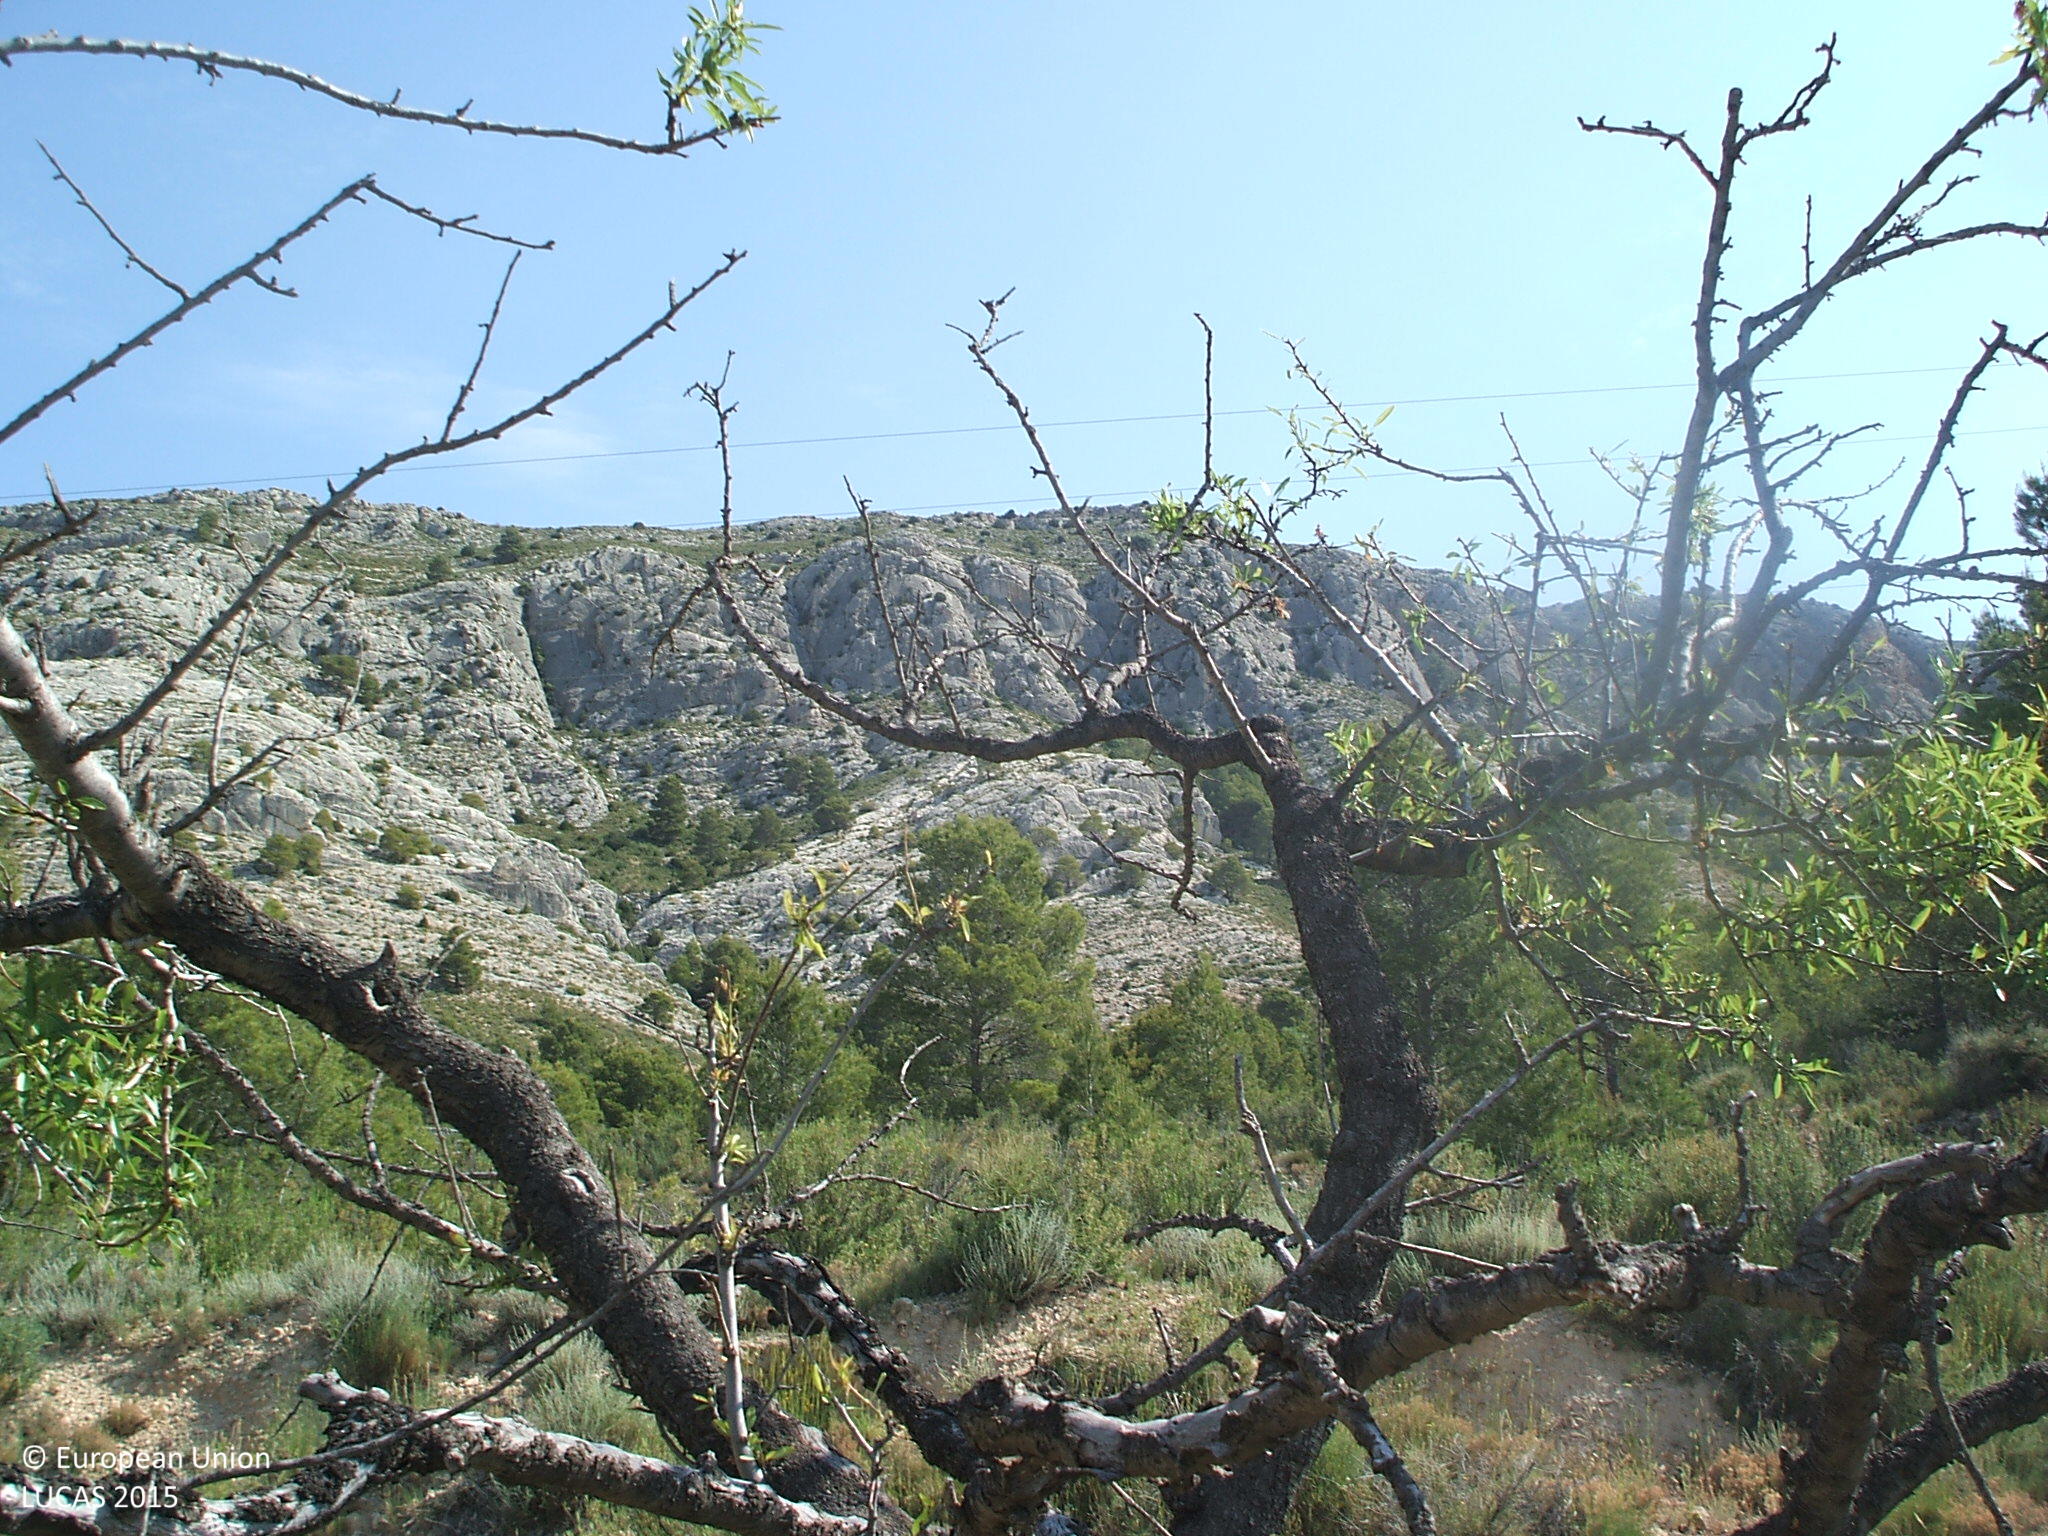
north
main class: Cropland
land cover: Nuts trees
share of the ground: 25 - 50 %
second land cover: Grassland without tree/shrub cover
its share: > 75 %
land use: Agriculture (excluding fallow land and kitchen gardens)
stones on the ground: > 50 %
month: June
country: ES
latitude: 40.7978
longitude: -0.3098
